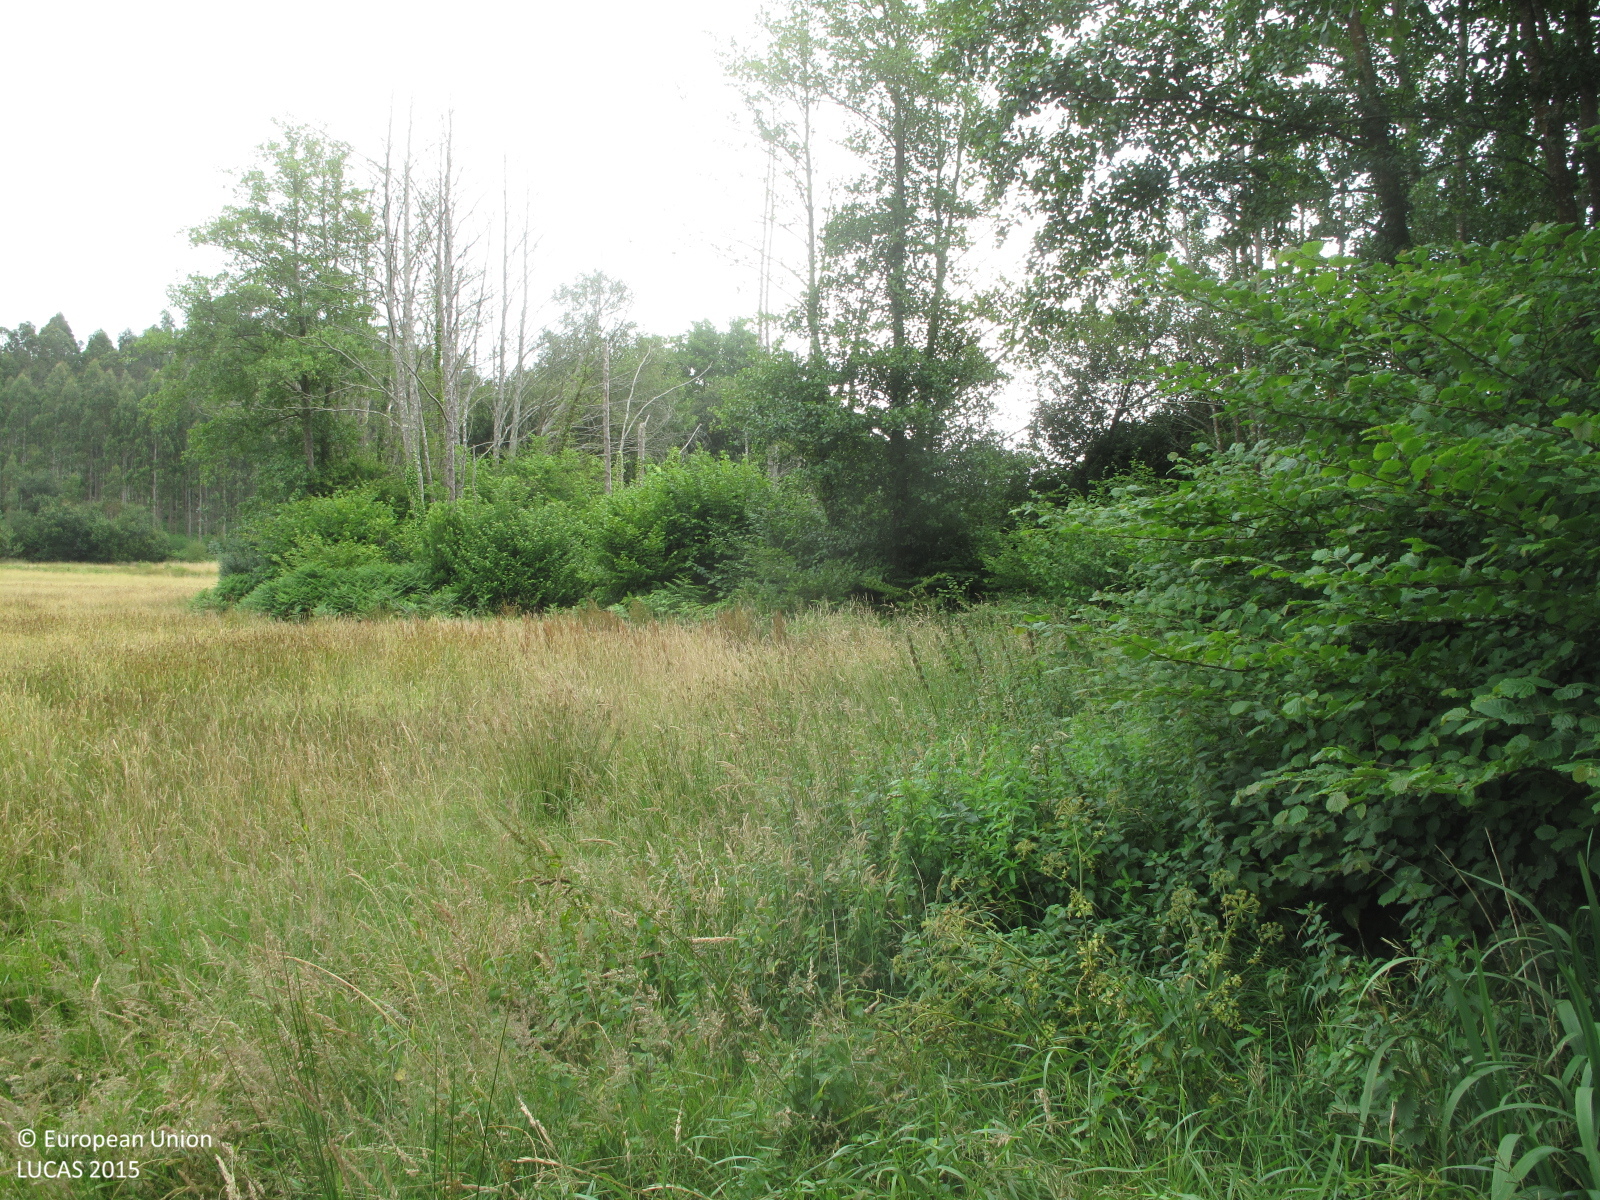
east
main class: Grassland
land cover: Grassland without tree/shrub cover
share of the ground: > 75 %
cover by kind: herbaceous plants 100 %
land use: Agriculture (excluding fallow land and kitchen gardens)
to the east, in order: Grassland without tree/shrub cover; Broadleaved woodland; Rivers and streams; Broadleaved woodland; Rivers and streams; Broadleaved woodland; Grassland without tree/shrub cover; Broadleaved woodland; Rivers and streams; Broadleaved woodland; Grassland without tree/shrub cover; Broadleaved woodland; Rivers and streams; Broadleaved woodland; Grassland without tree/shrub cover; Fences; Grassland without tree/shrub cover; Electric lines; Grassland without tree/shrub cover
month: July
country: ES
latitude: 43.5828
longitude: -8.0434
